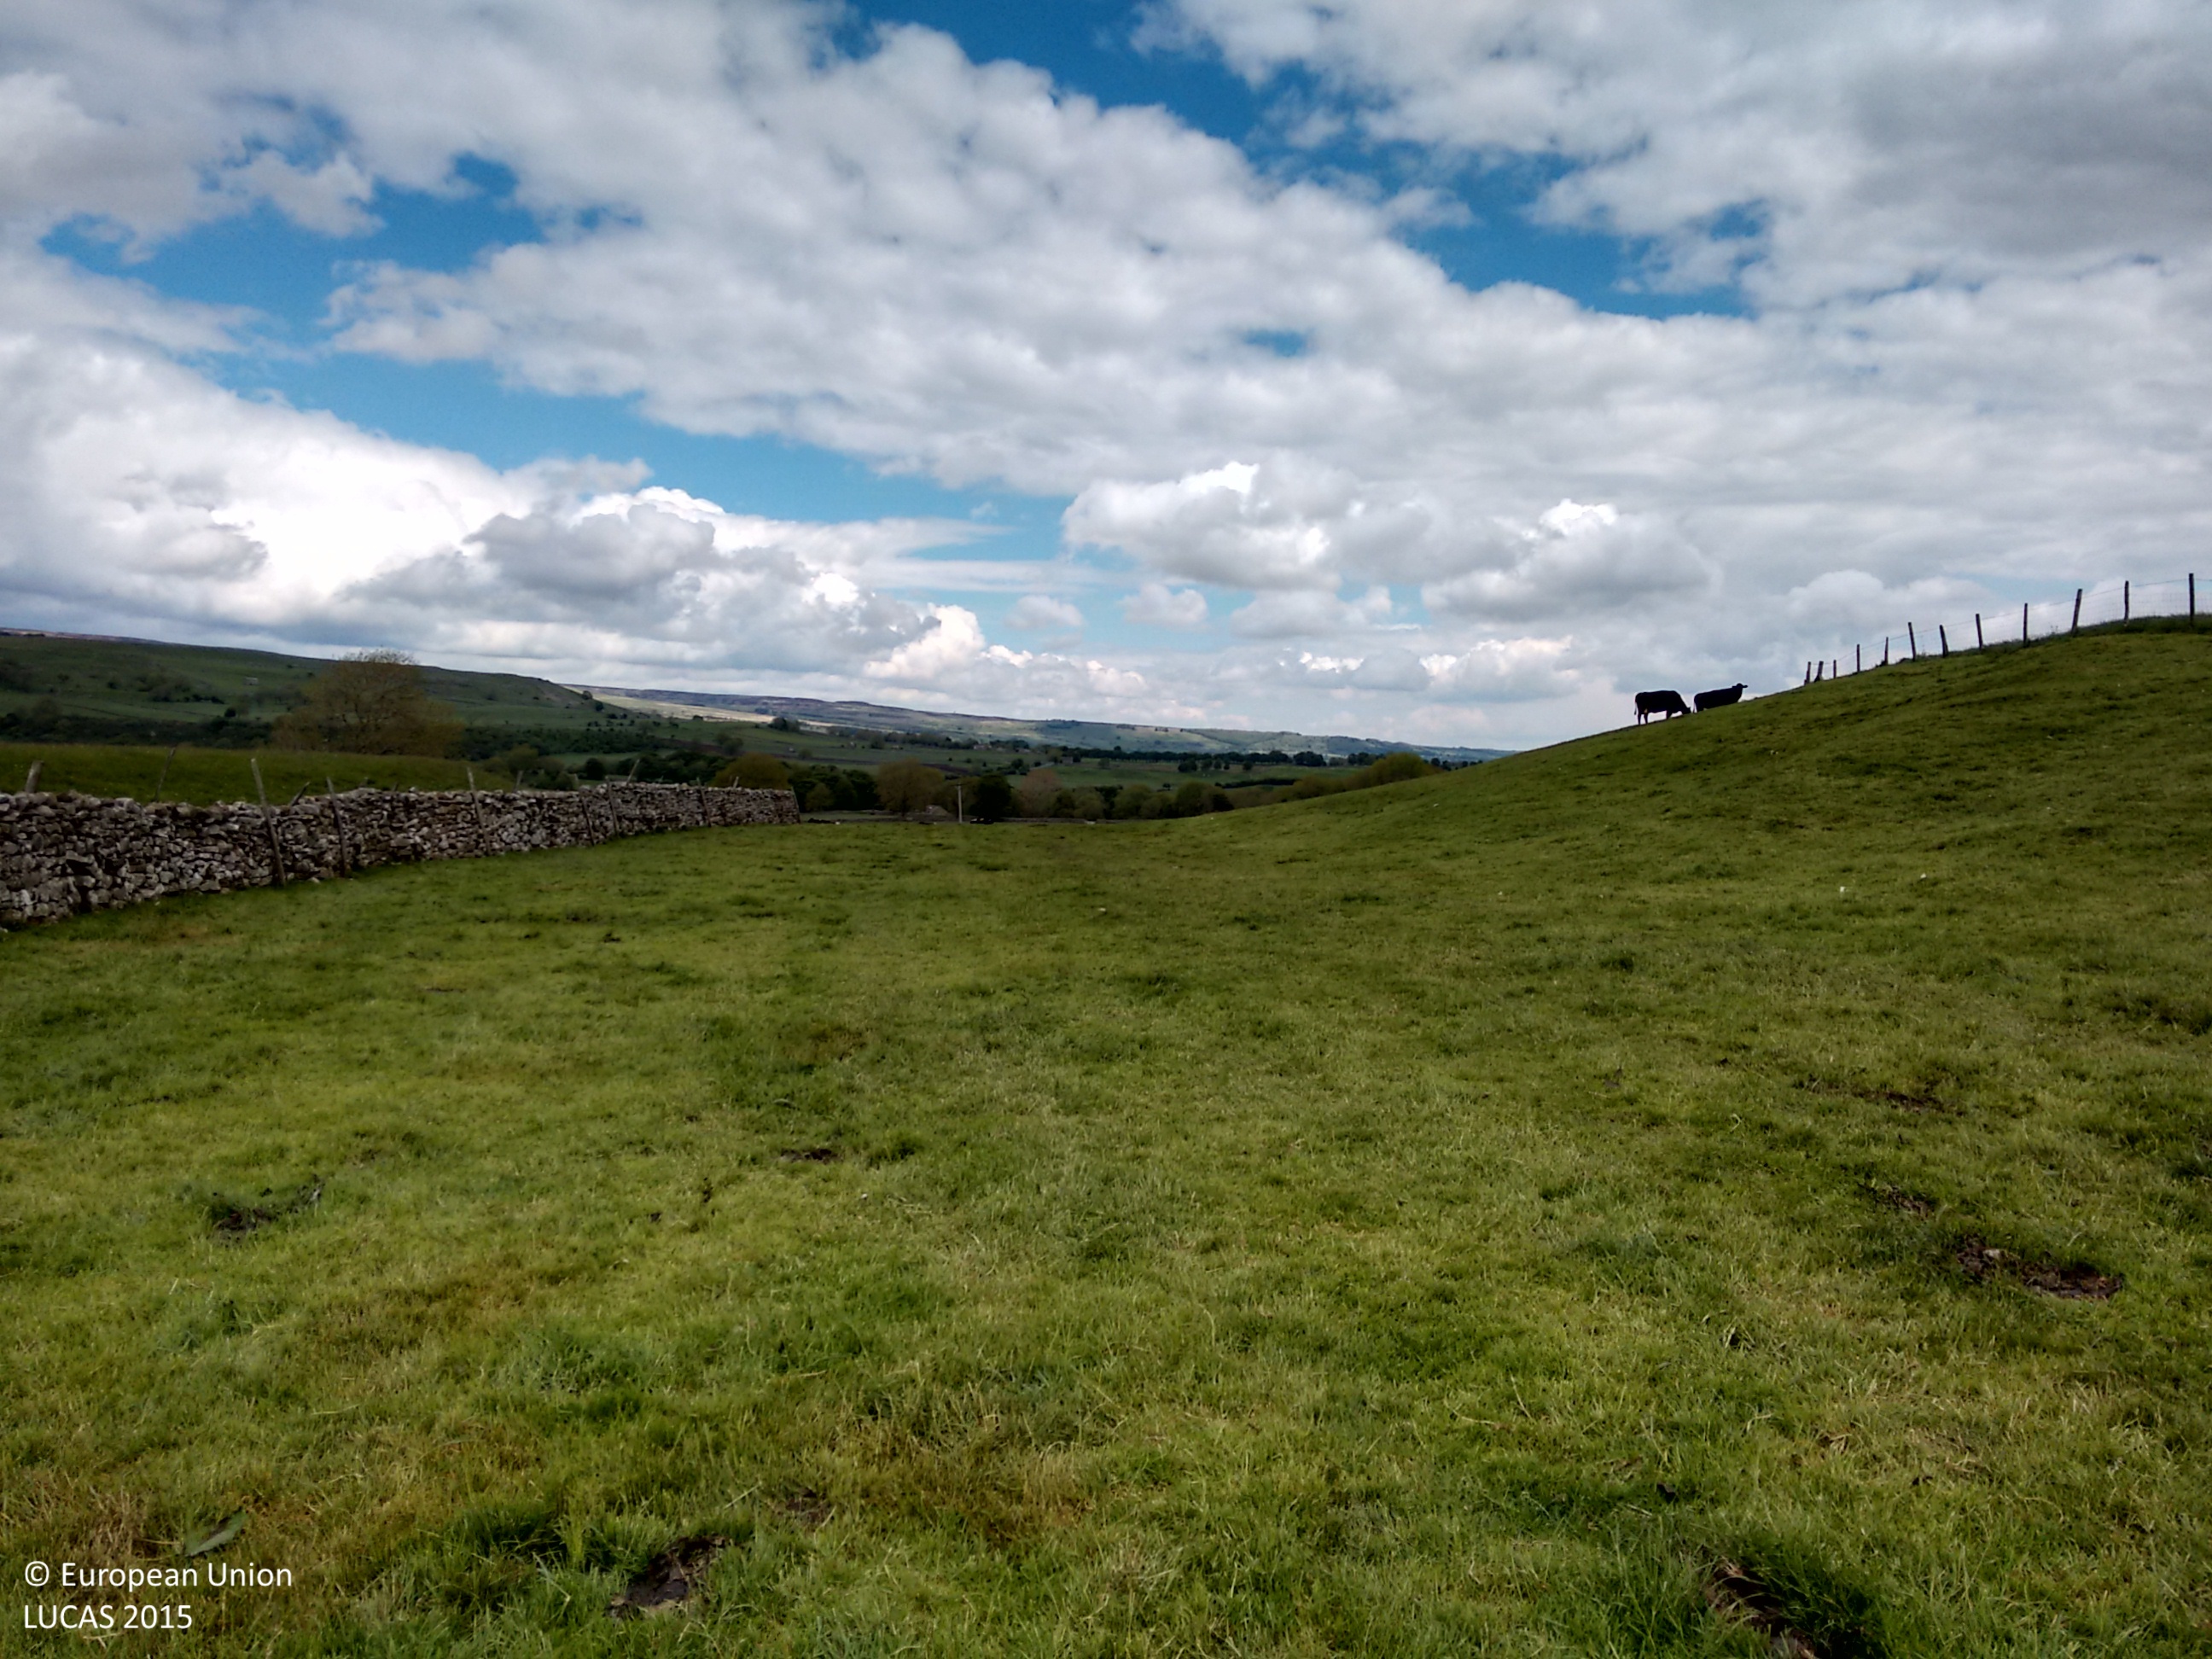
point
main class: Grassland
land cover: Grassland without tree/shrub cover
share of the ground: > 75 %
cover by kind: herbaceous plants 100 %
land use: Agriculture (excluding fallow land and kitchen gardens)
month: June
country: GB
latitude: 54.2916
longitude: -2.0246
